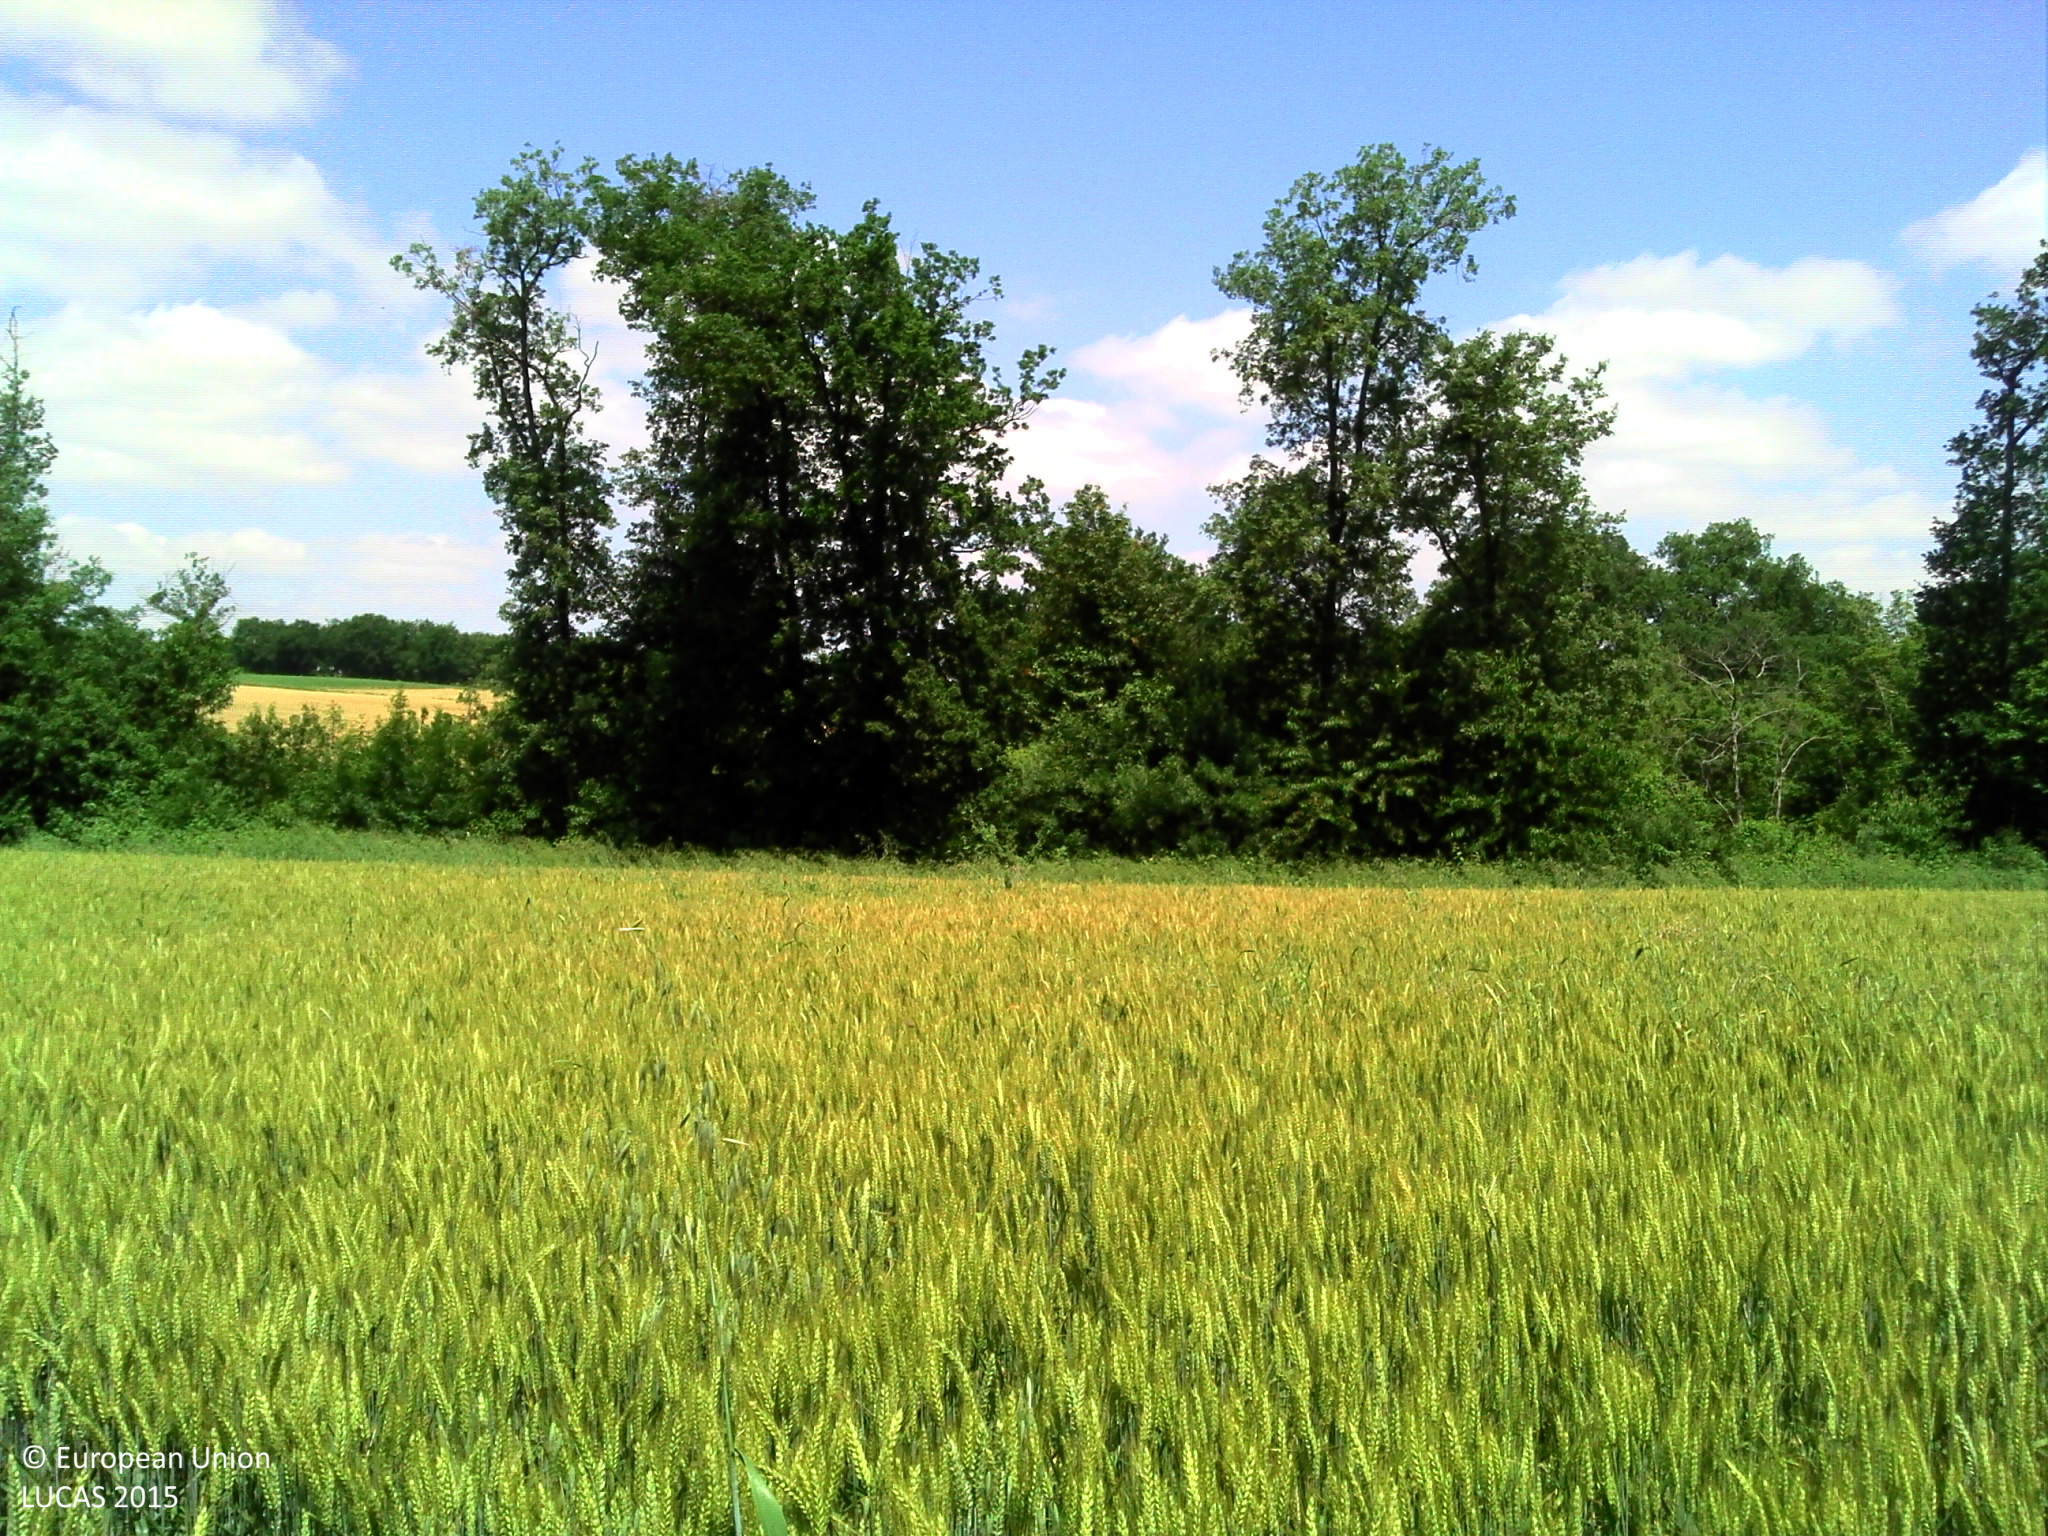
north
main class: Cropland
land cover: Common wheat
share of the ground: > 75 %
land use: Agriculture (excluding fallow land and kitchen gardens)
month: June
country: FR
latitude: 43.6295
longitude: 0.7653
